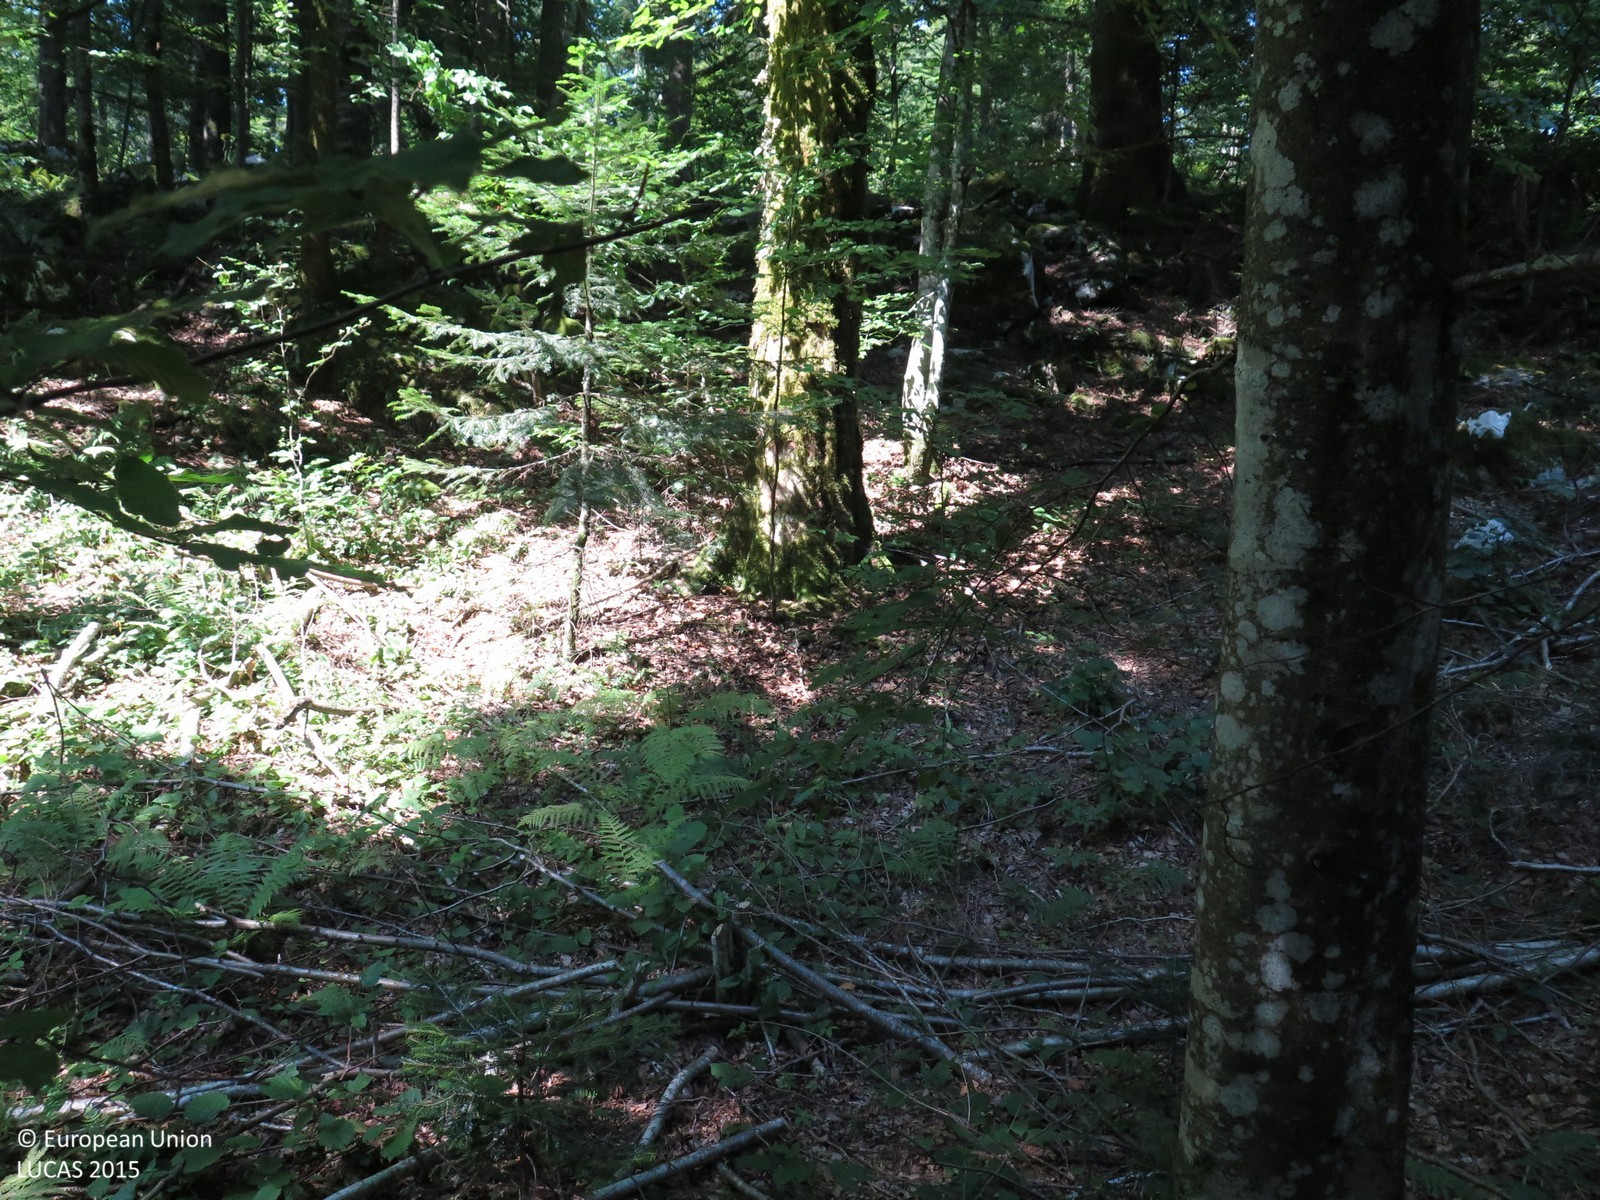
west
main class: Woodland
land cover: Other mixed woodland
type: beech forest
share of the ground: > 75 %
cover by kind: broadleaved forest trees 75 %, coniferous forest trees 25 %
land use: Forestry
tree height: > 5 m
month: August
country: HR
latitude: 45.4188
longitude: 15.0689
